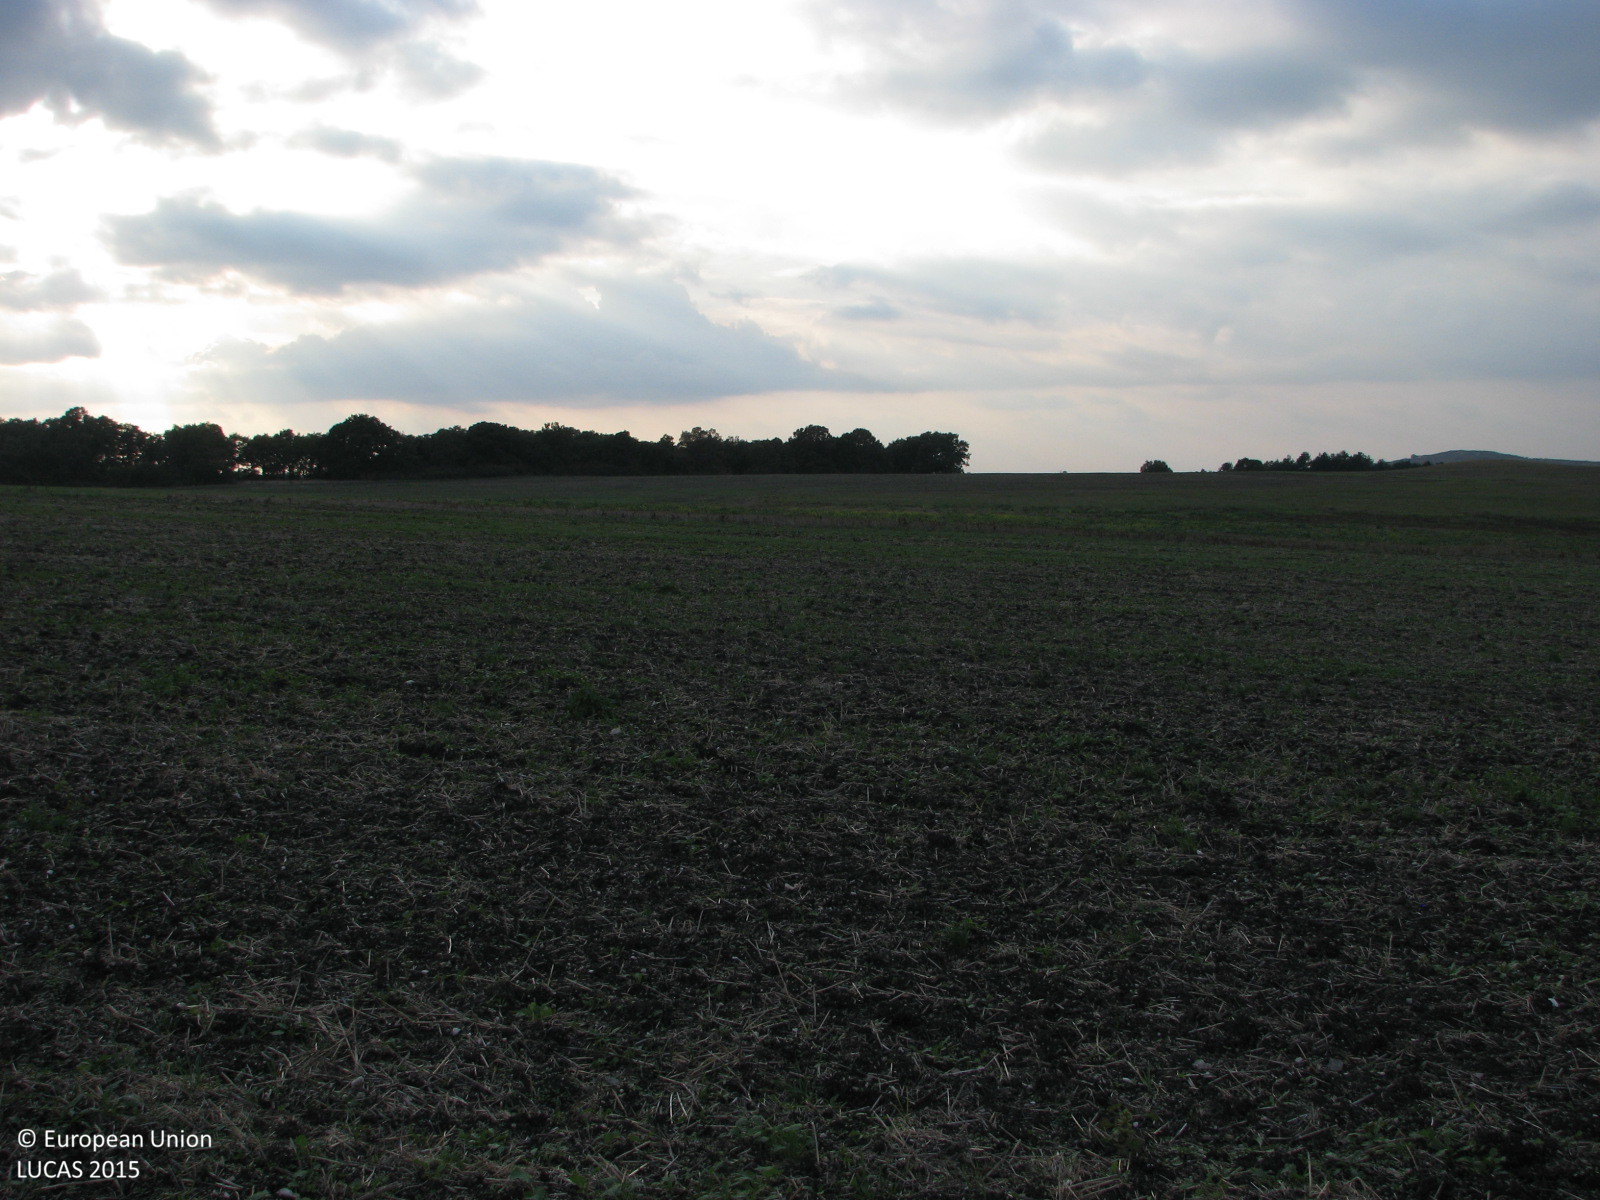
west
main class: Cropland
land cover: Common wheat
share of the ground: 10 - 25 %
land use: Agriculture (excluding fallow land and kitchen gardens)
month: October
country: BG
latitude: 42.2735
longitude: 26.6681
